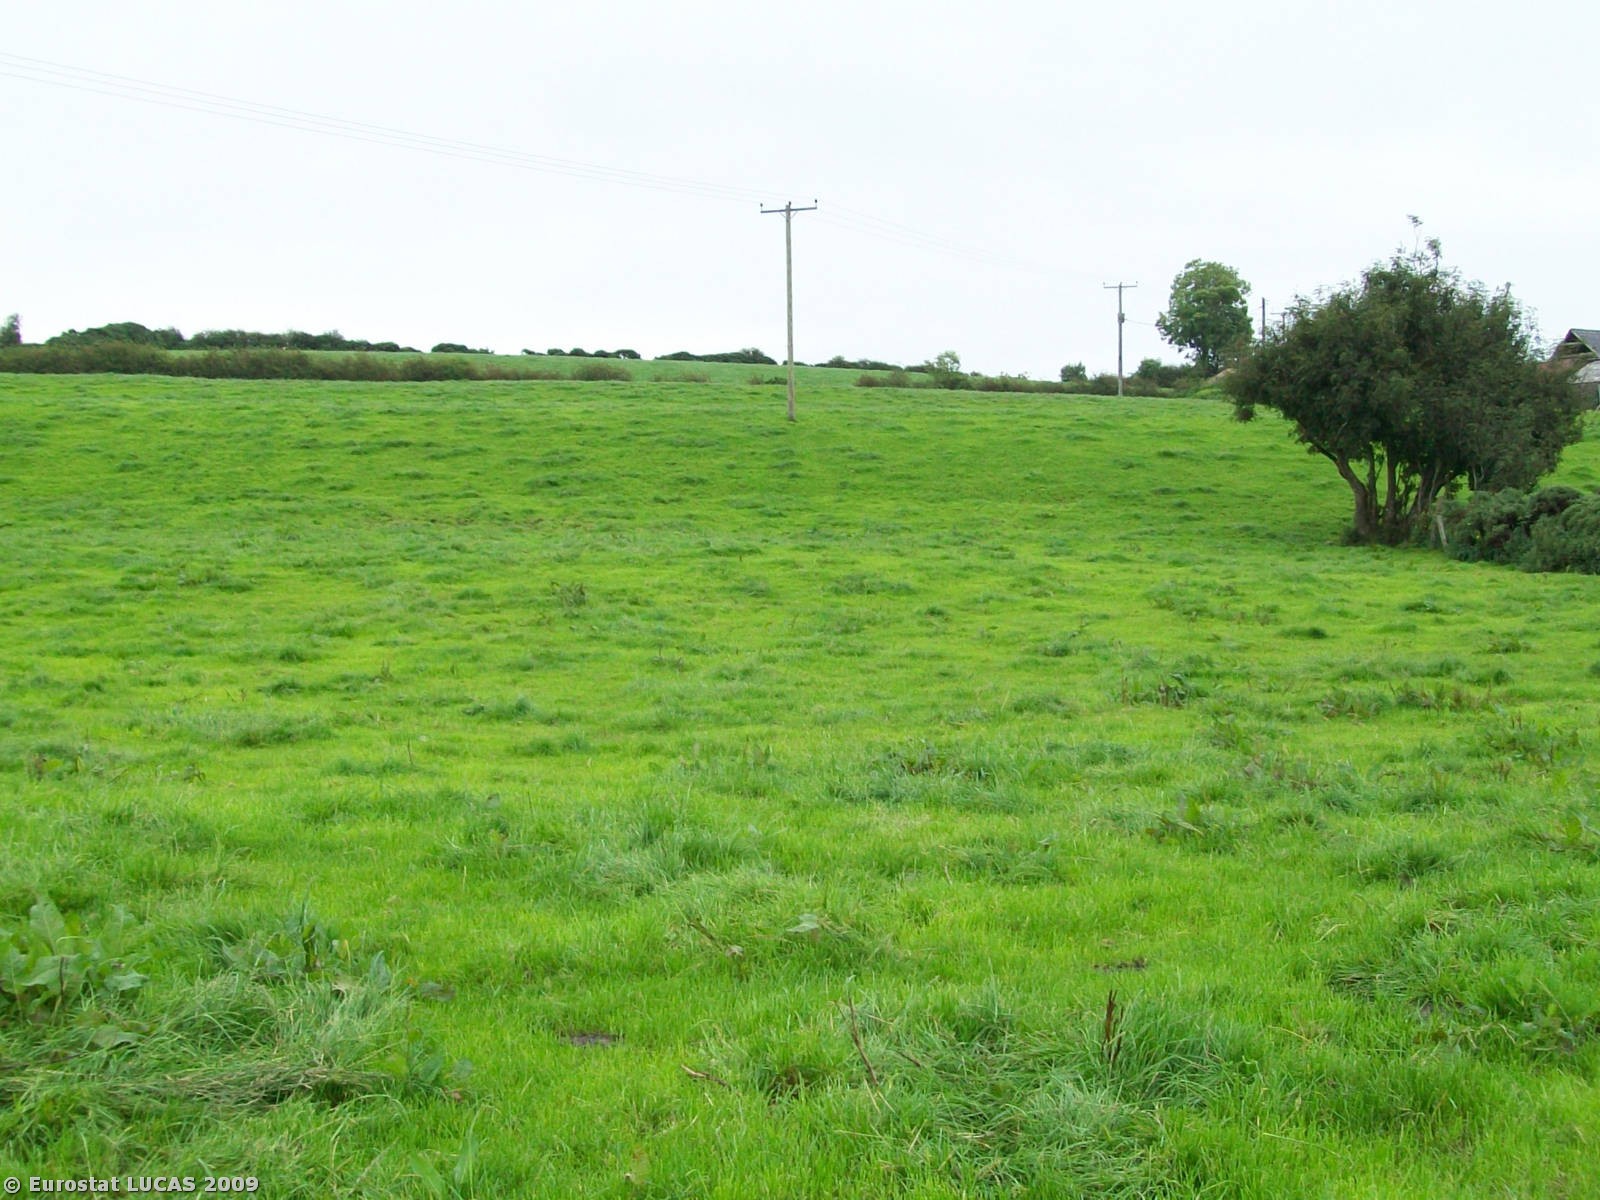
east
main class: Grassland
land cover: Grassland without tree/shrub cover
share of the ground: > 75 %
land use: Agriculture (excluding fallow land and kitchen gardens)
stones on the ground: 10 - 25 %
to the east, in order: Grassland without tree/shrub cover; Abandoned hedges; Ditches and canals; Grassland without tree/shrub cover; Artificial constructions in urban areas; Grassland without tree/shrub cover; Electric lines; Grassland without tree/shrub cover; Ditches and canals; Abandoned hedges; Single bushes/trees; Grassland without tree/shrub cover
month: August
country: GB
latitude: 54.1712
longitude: -6.6271
